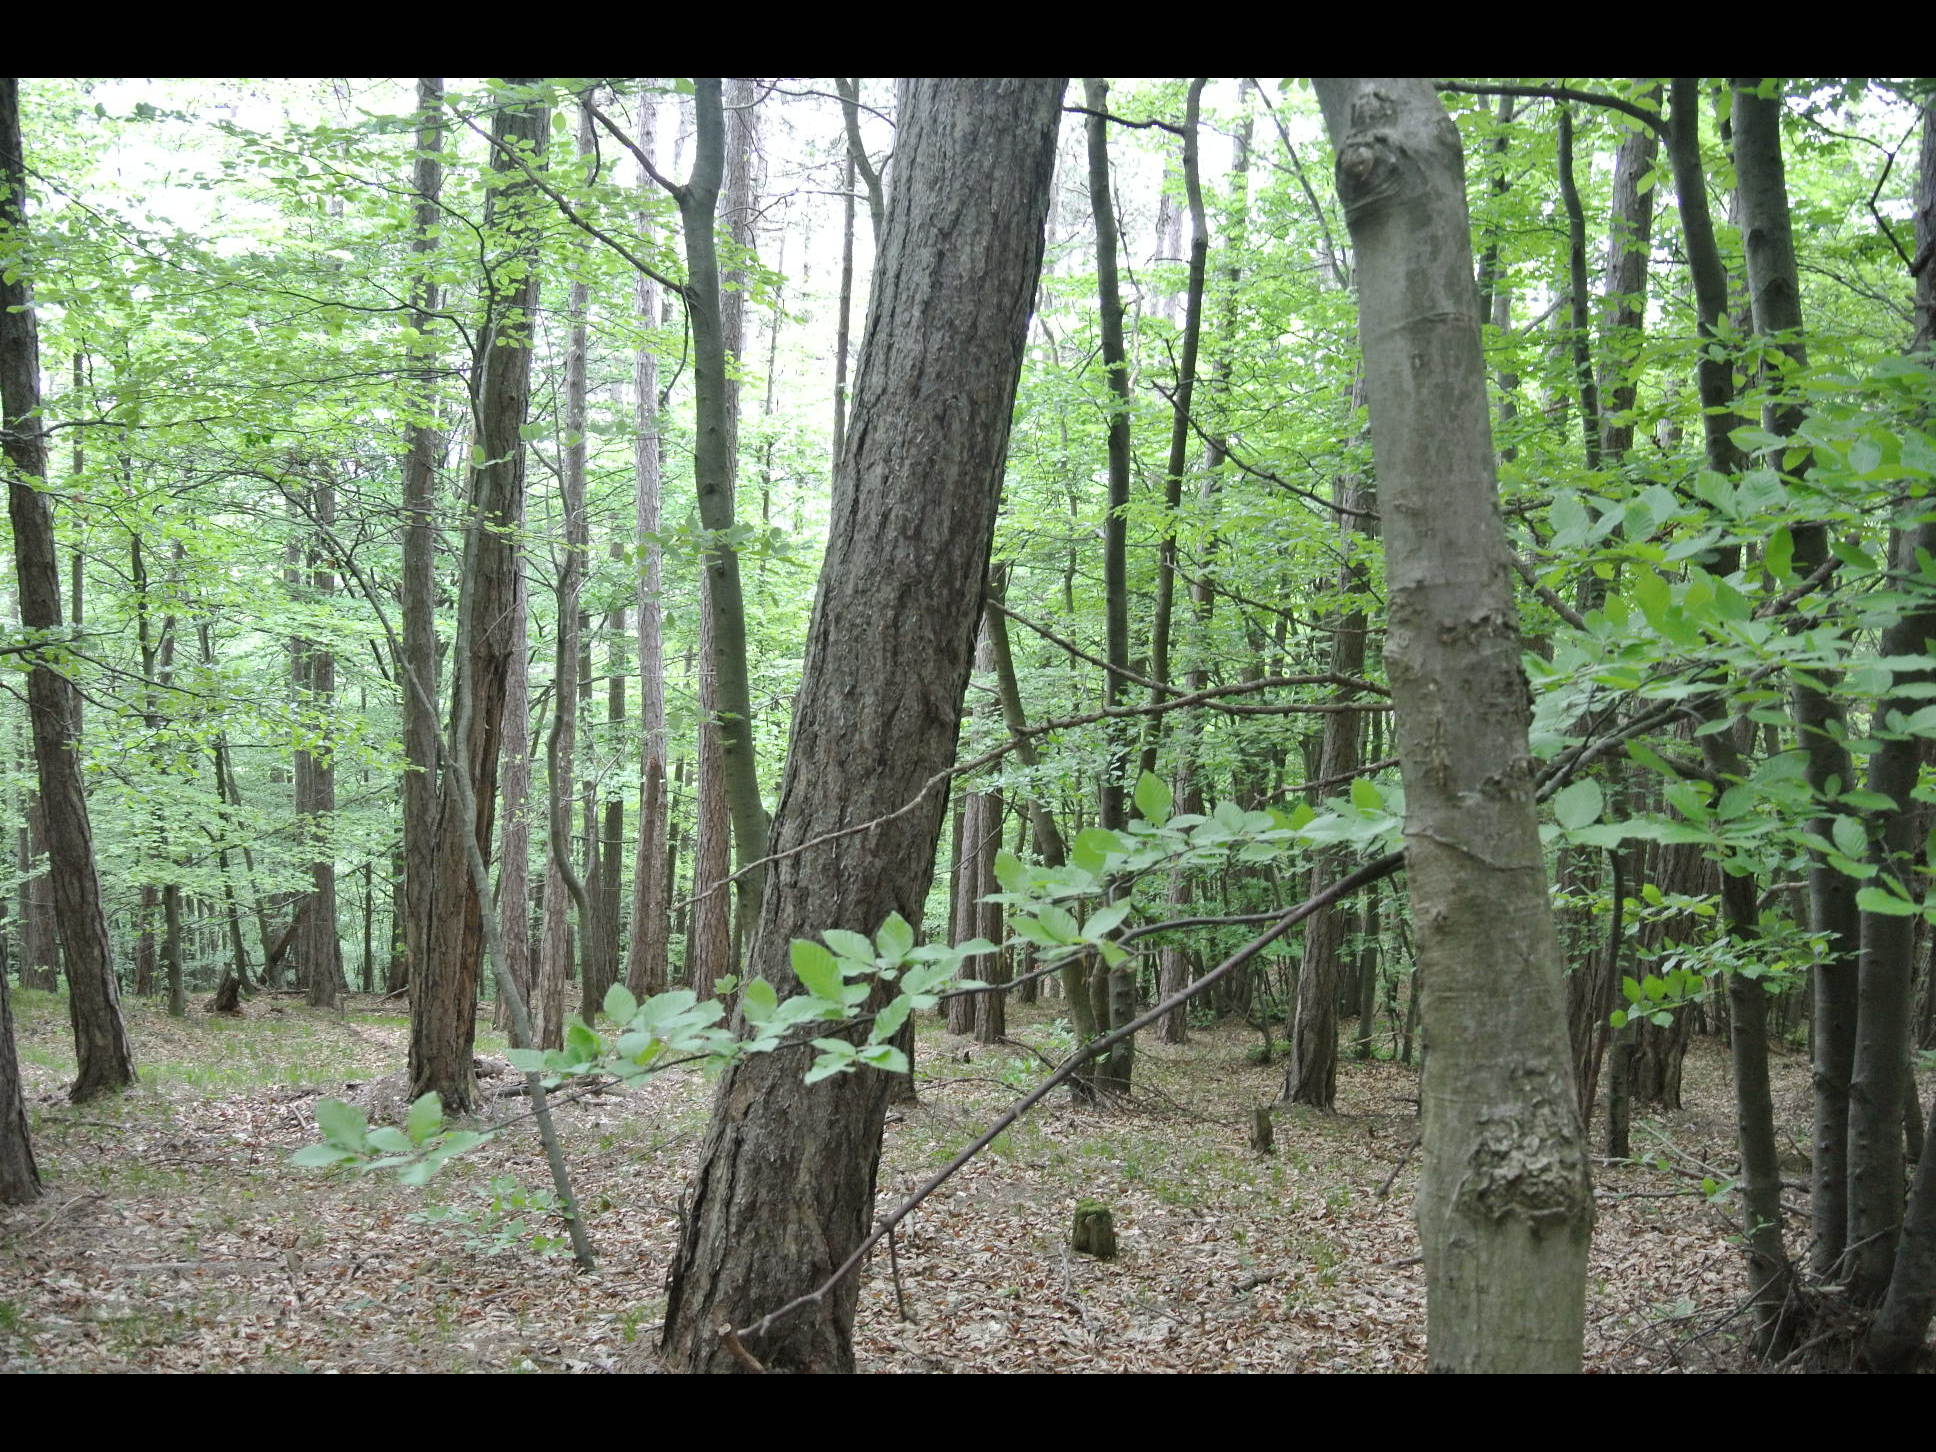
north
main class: Woodland
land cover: Pine dominated mixed woodland
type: alpine coniferous forest
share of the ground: > 75 %
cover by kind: coniferous forest trees 50 %, broadleaved forest trees 50 %
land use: Forestry
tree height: > 5 m
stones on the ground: < 10 %
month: May
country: AT
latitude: 47.9675
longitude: 16.0442
